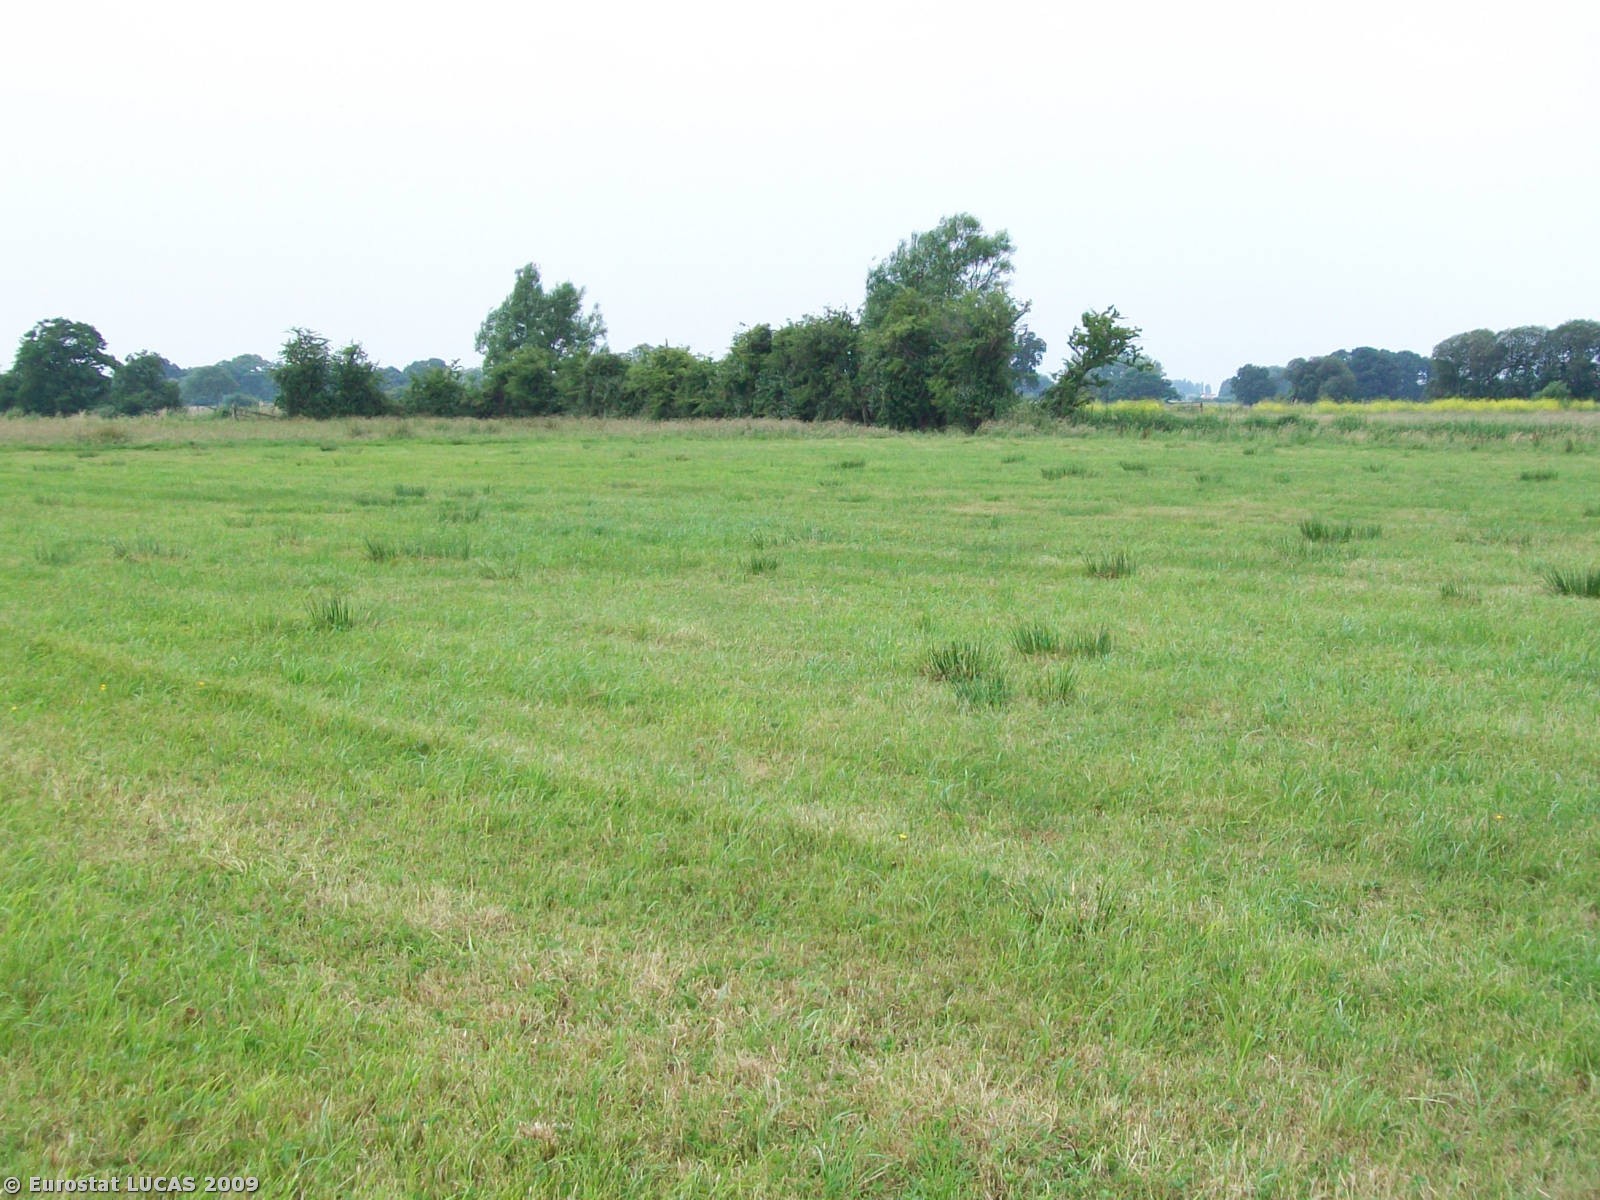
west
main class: Grassland
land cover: Grassland without tree/shrub cover
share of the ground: > 75 %
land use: Agriculture (excluding fallow land and kitchen gardens)
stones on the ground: < 10 %
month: July
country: GB
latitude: 51.1964
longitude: -2.7350
